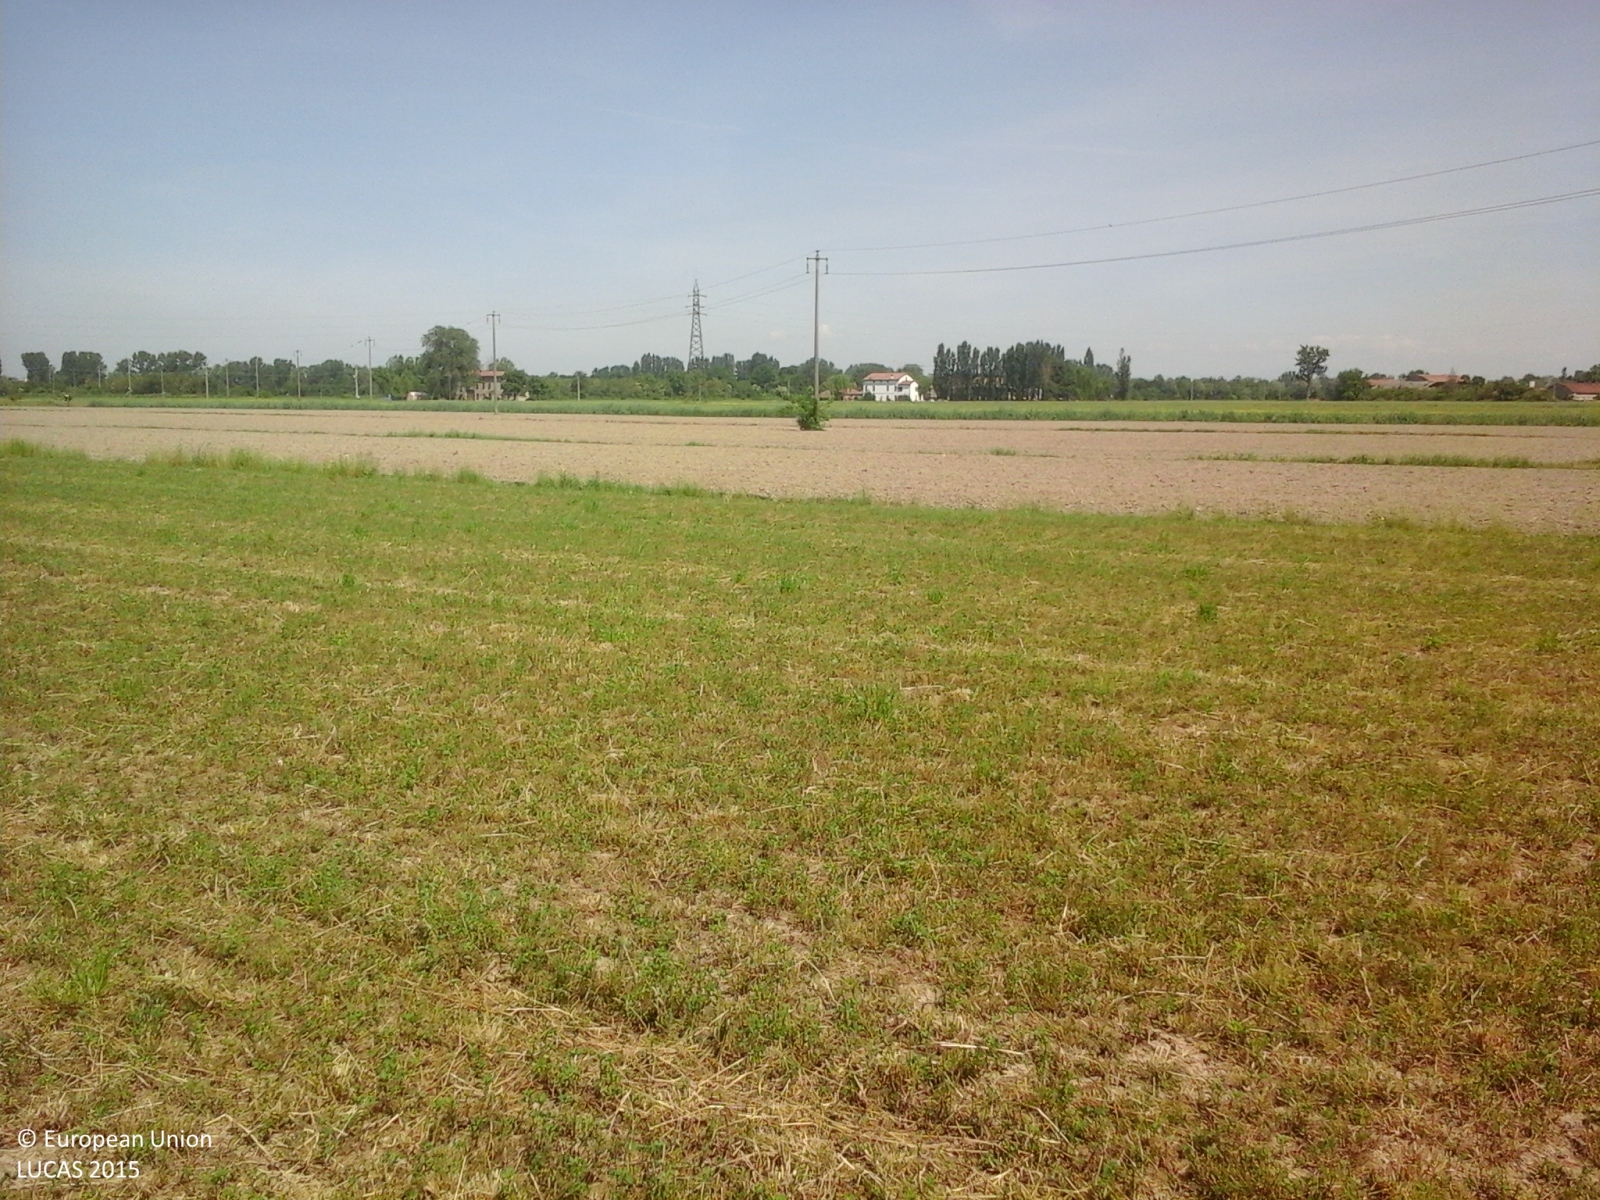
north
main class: Cropland
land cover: Lucerne
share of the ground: > 75 %
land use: Agriculture (excluding fallow land and kitchen gardens)
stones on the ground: < 10 %
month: May
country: IT
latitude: 44.9780
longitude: 10.8733
